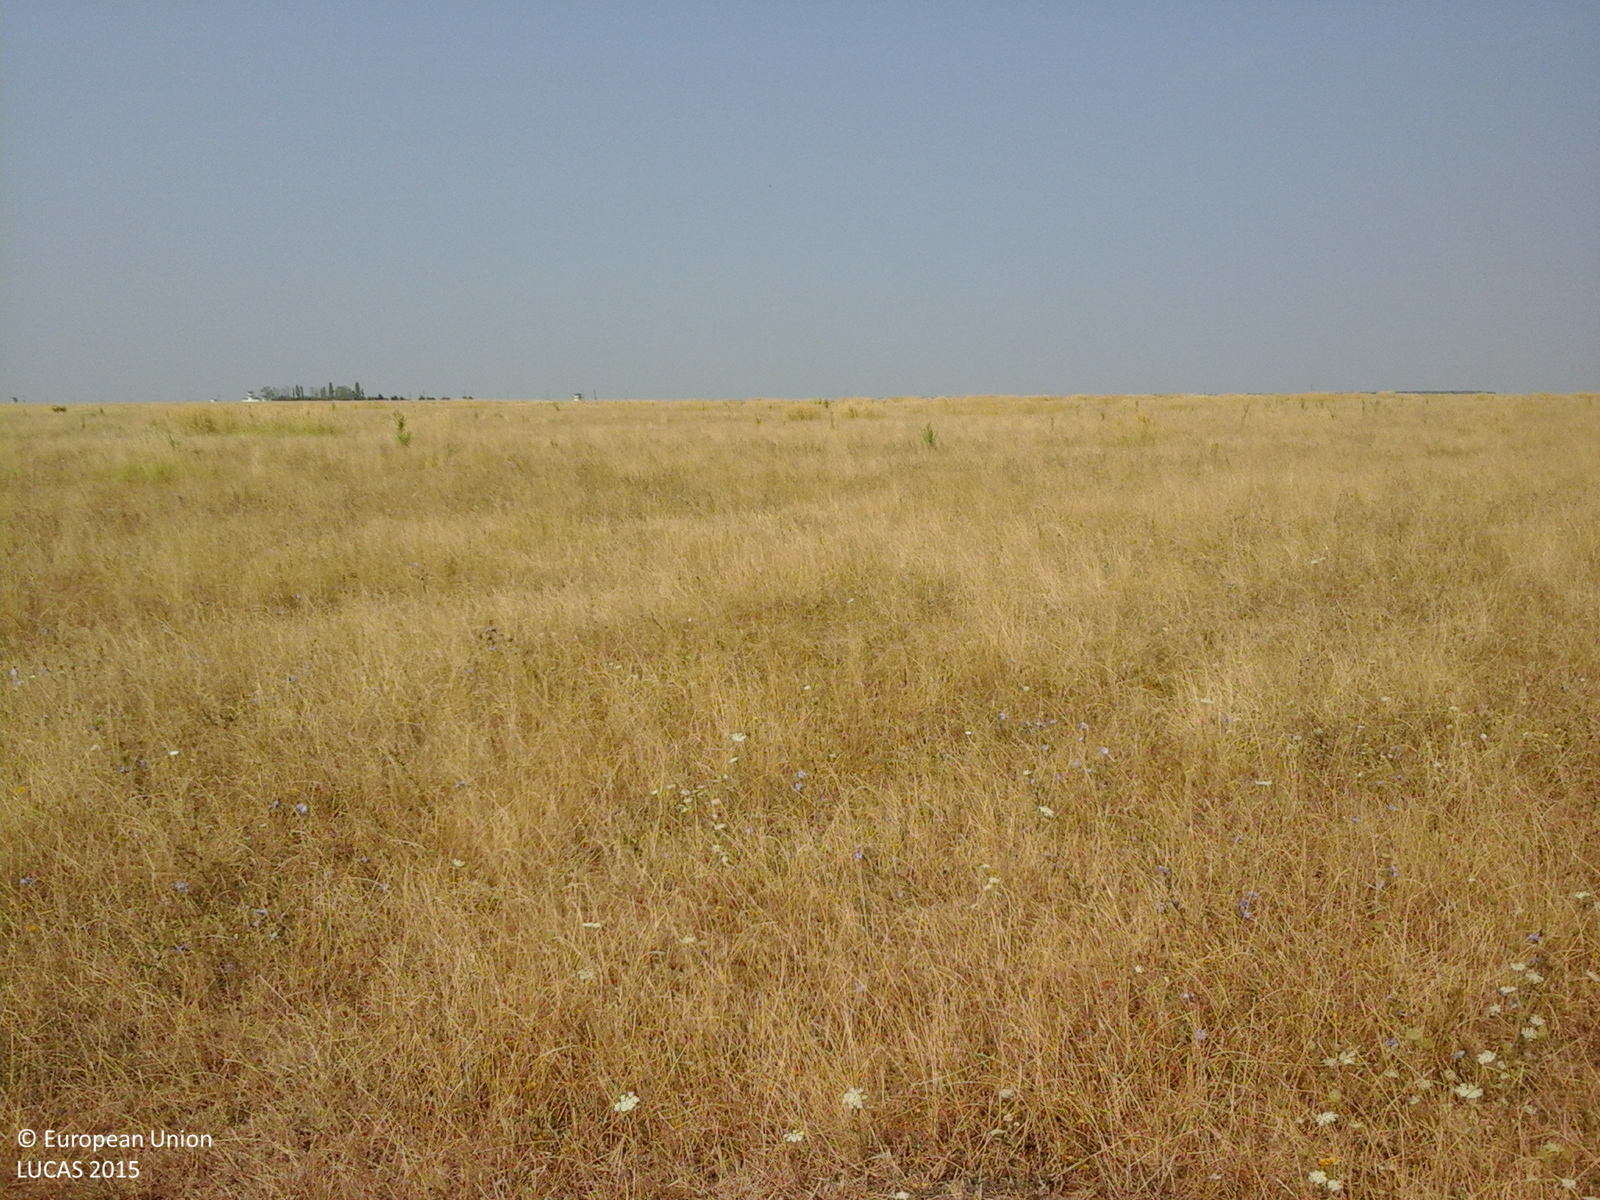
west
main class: Grassland
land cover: Grassland without tree/shrub cover
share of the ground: > 75 %
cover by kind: herbaceous plants 100 %
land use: Agriculture (excluding fallow land and kitchen gardens)
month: August
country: RO
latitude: 44.4194
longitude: 23.1723
